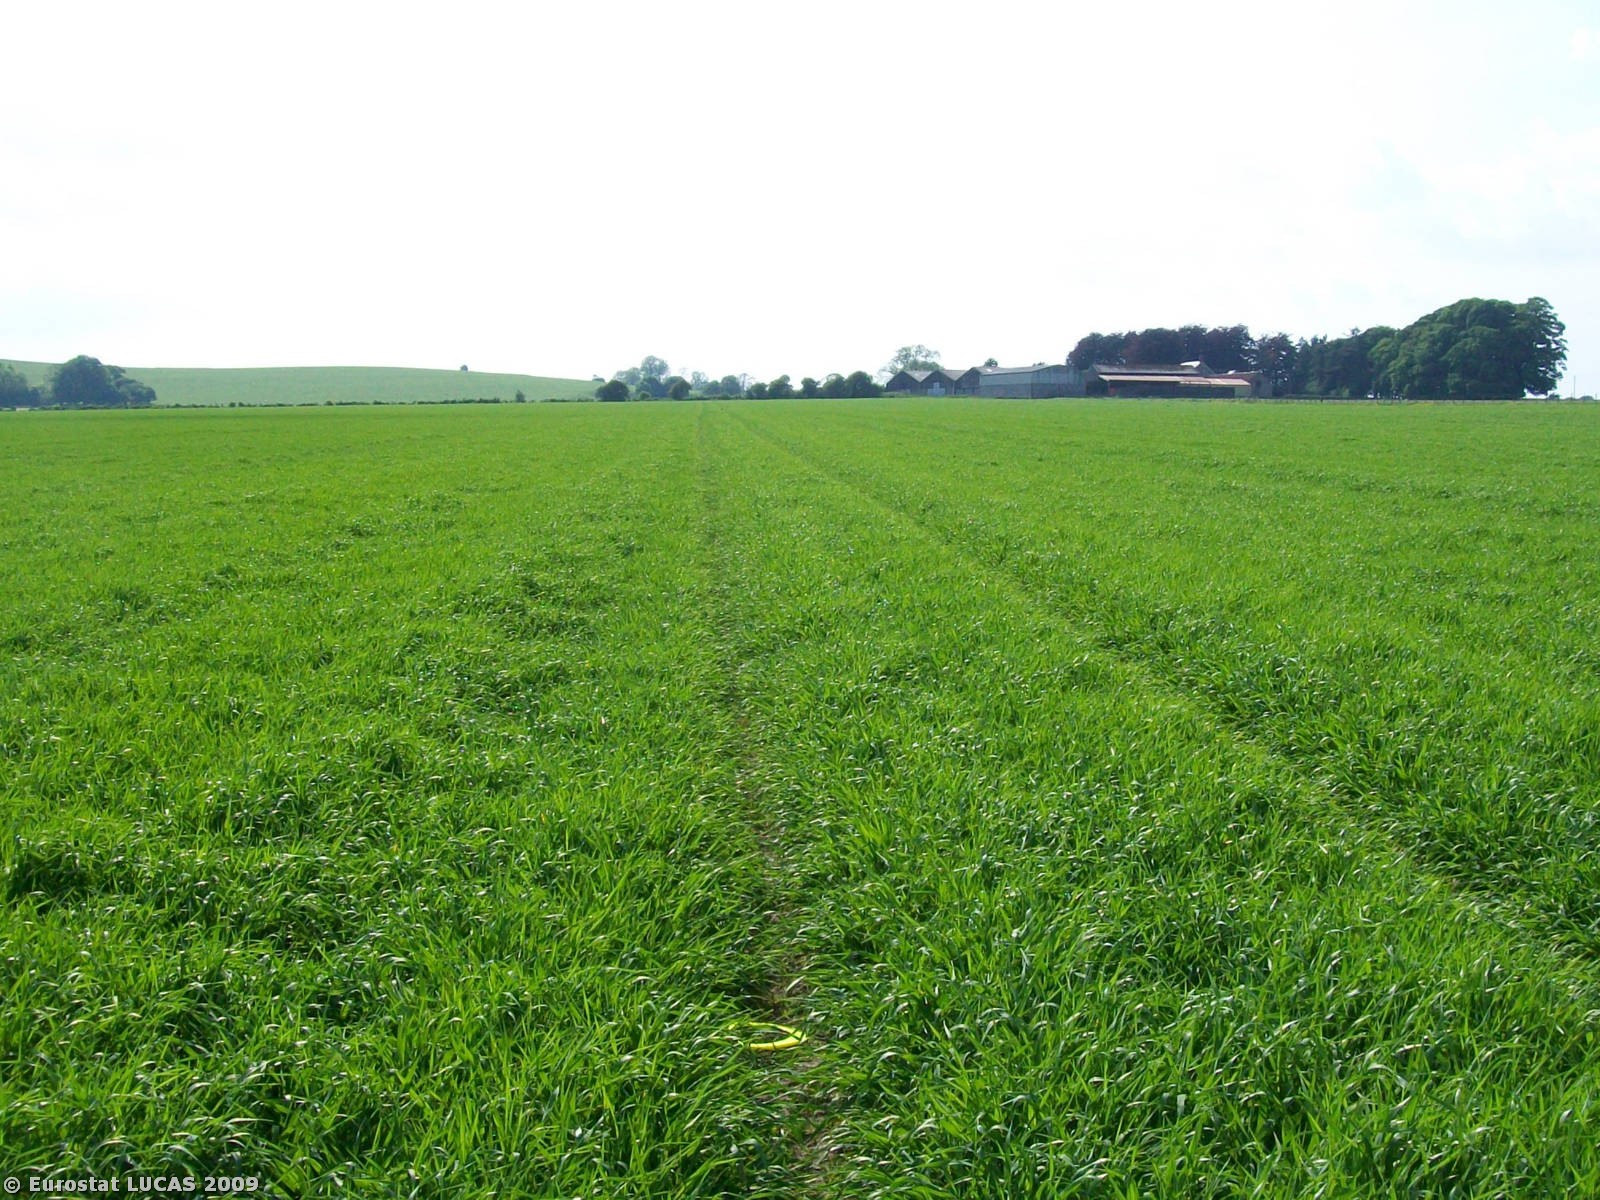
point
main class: Cropland
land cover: Barley
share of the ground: > 75 %
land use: Agriculture (excluding fallow land and kitchen gardens)
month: May
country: GB
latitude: 51.1600
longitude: -2.2305
